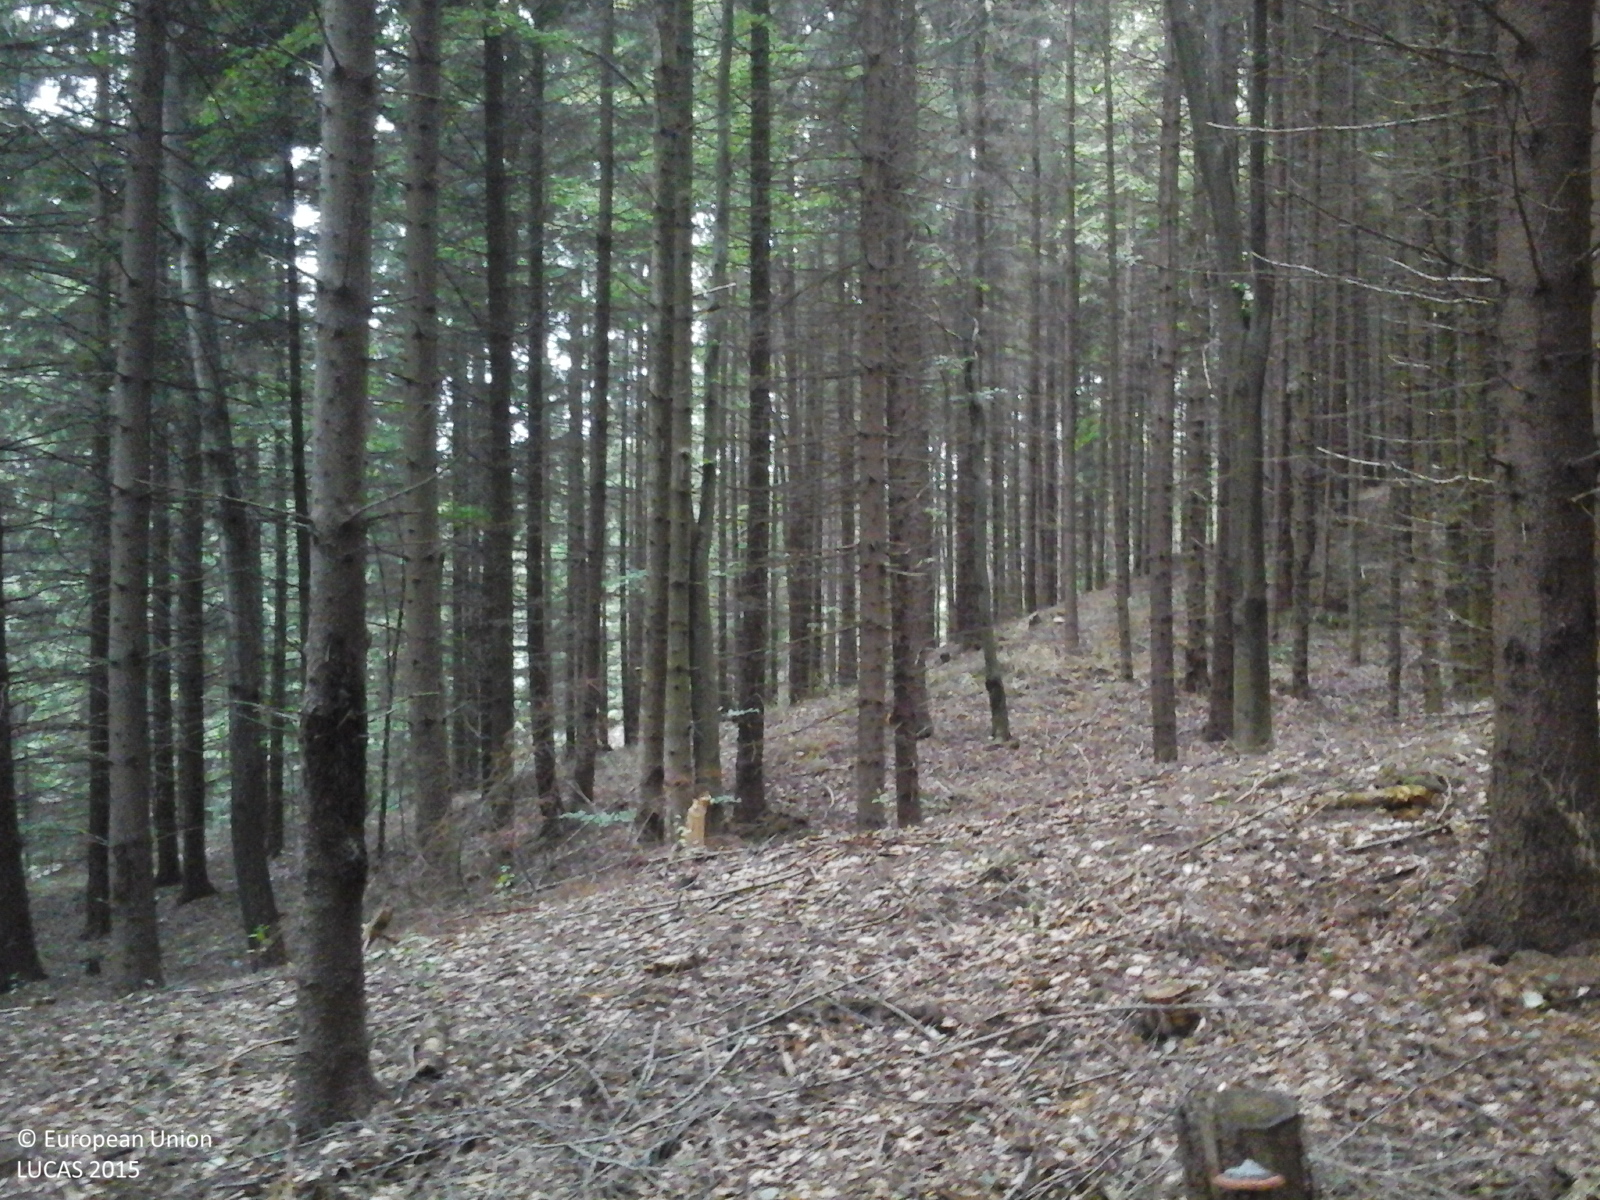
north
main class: Woodland
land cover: Spruce dominated coniferous woodland
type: alpine coniferous forest
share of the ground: > 75 %
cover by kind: coniferous forest trees 100 %
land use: Forestry
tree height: > 5 m
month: June
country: RO
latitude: 47.1131
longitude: 26.2772
